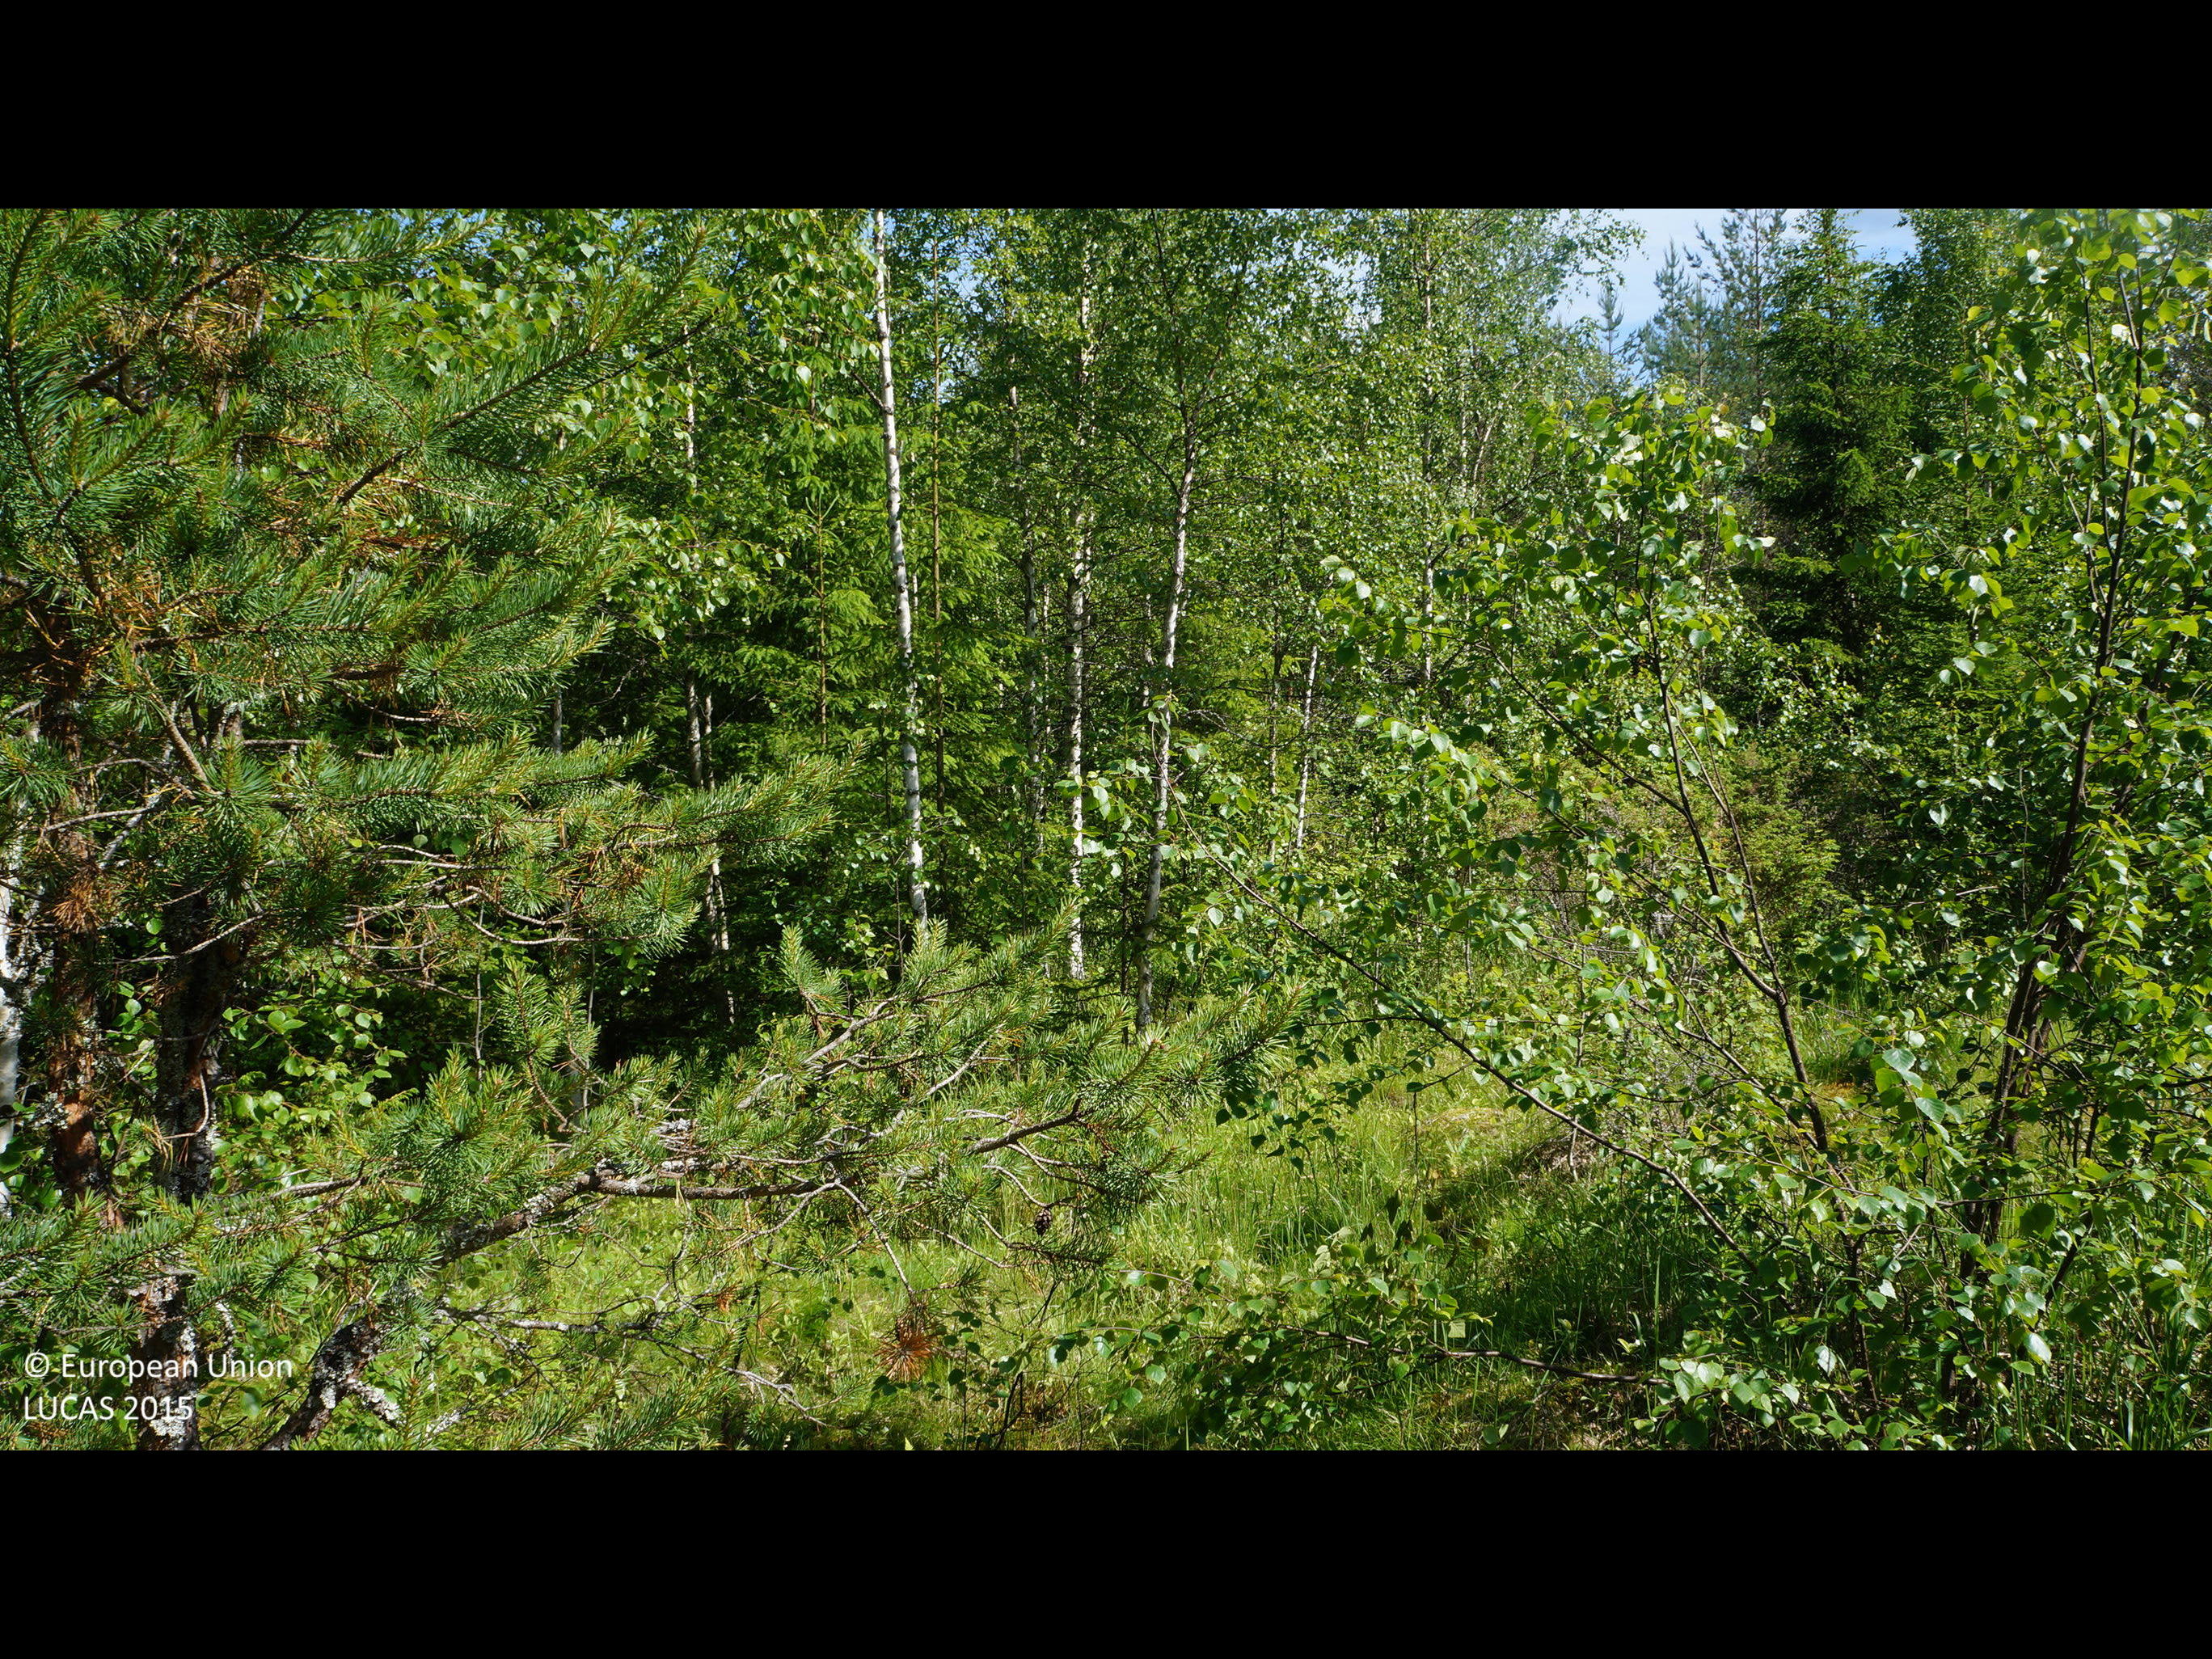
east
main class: Woodland
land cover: Broadleaved woodland
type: boreal forest
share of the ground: 50 - 75 %
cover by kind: broadleaved forest trees 40 %, shrubs 30 %, herbaceous plants 20 %, coniferous forest trees 10 %
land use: Forestry
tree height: > 5 m
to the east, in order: Broadleaved woodland; Tracks; Pine dominated coniferous woodland; Ditches and canals; Broadleaved woodland; Ditches and canals; Broadleaved woodland; Ditches and canals; Spruce dominated mixed woodland; Pine dominated coniferous woodland; Spruce dominated mixed woodland; Broadleaved woodland
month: July
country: FI
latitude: 64.1740
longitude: 24.4530
